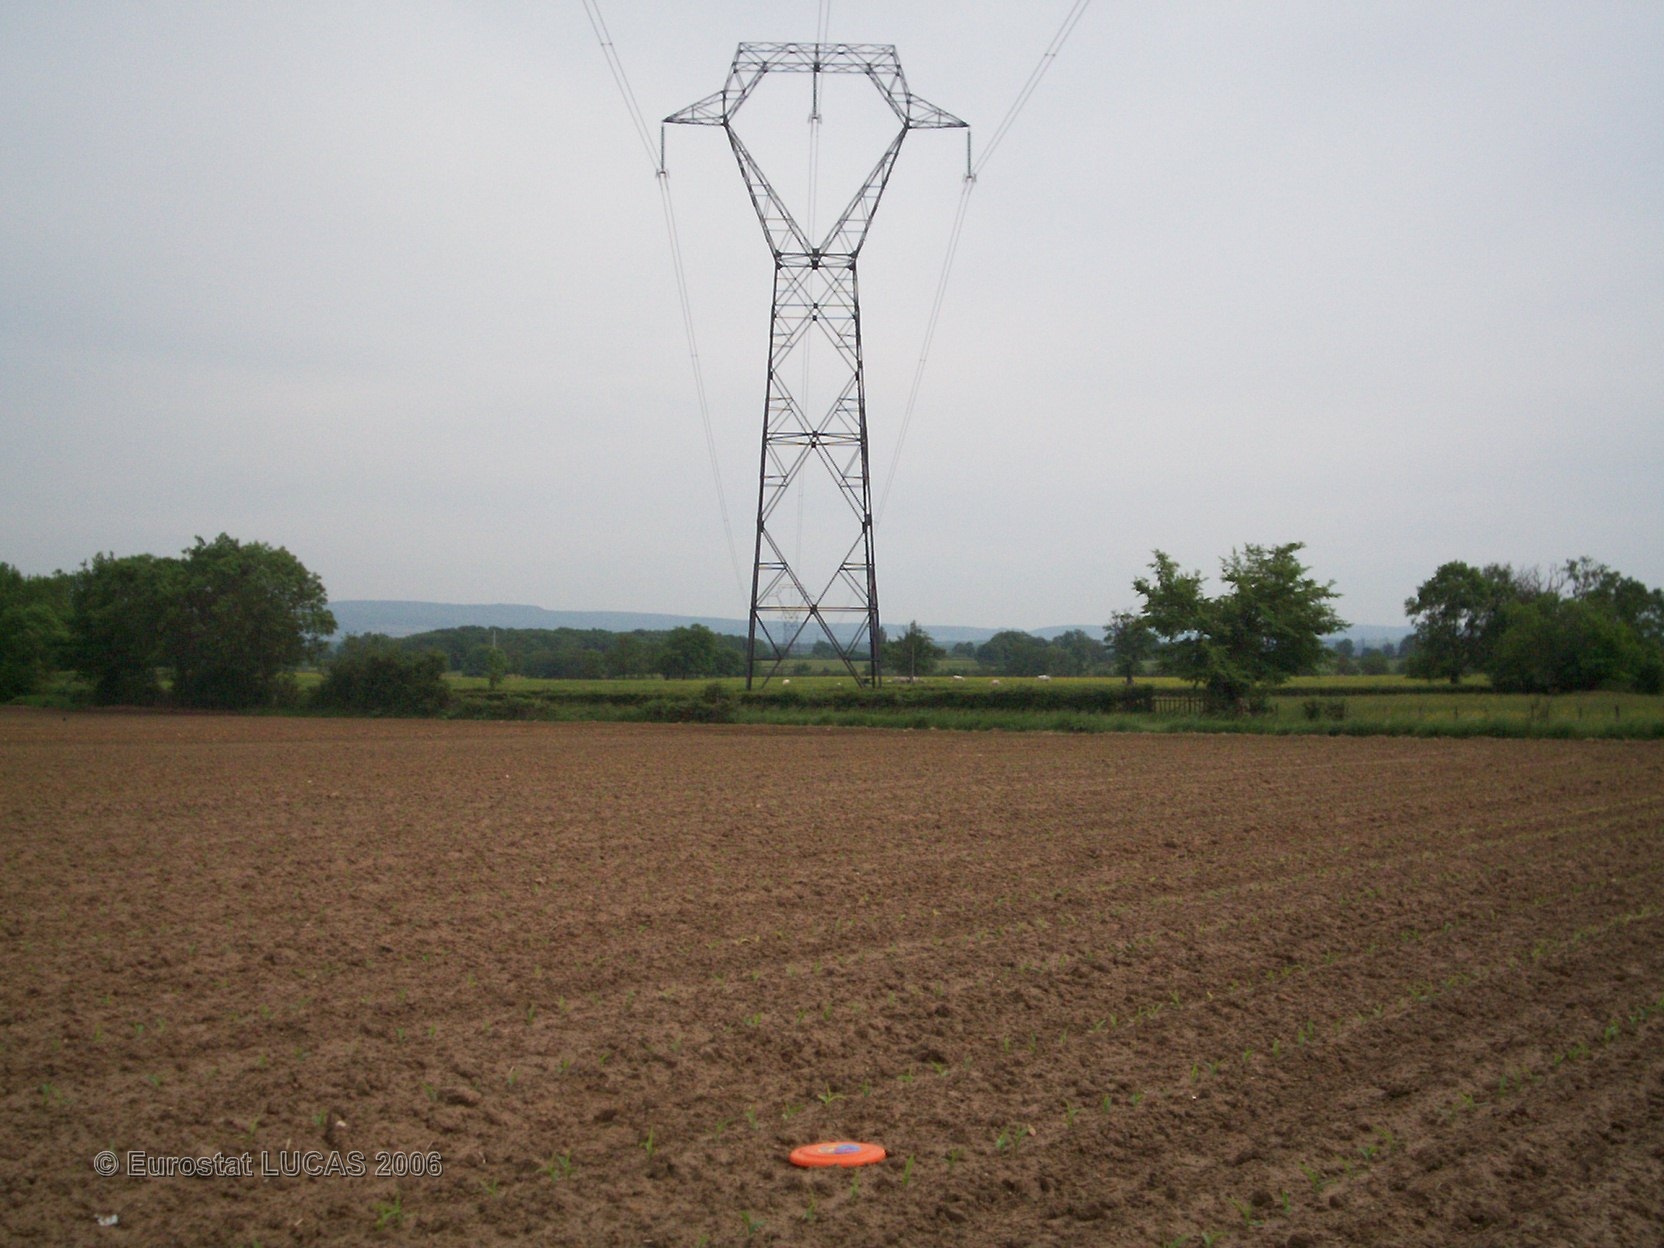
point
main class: Cropland
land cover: Maize
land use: Agriculture (excluding fallow land and kitchen gardens)
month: May
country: FR
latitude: 46.6534
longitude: 4.7092
